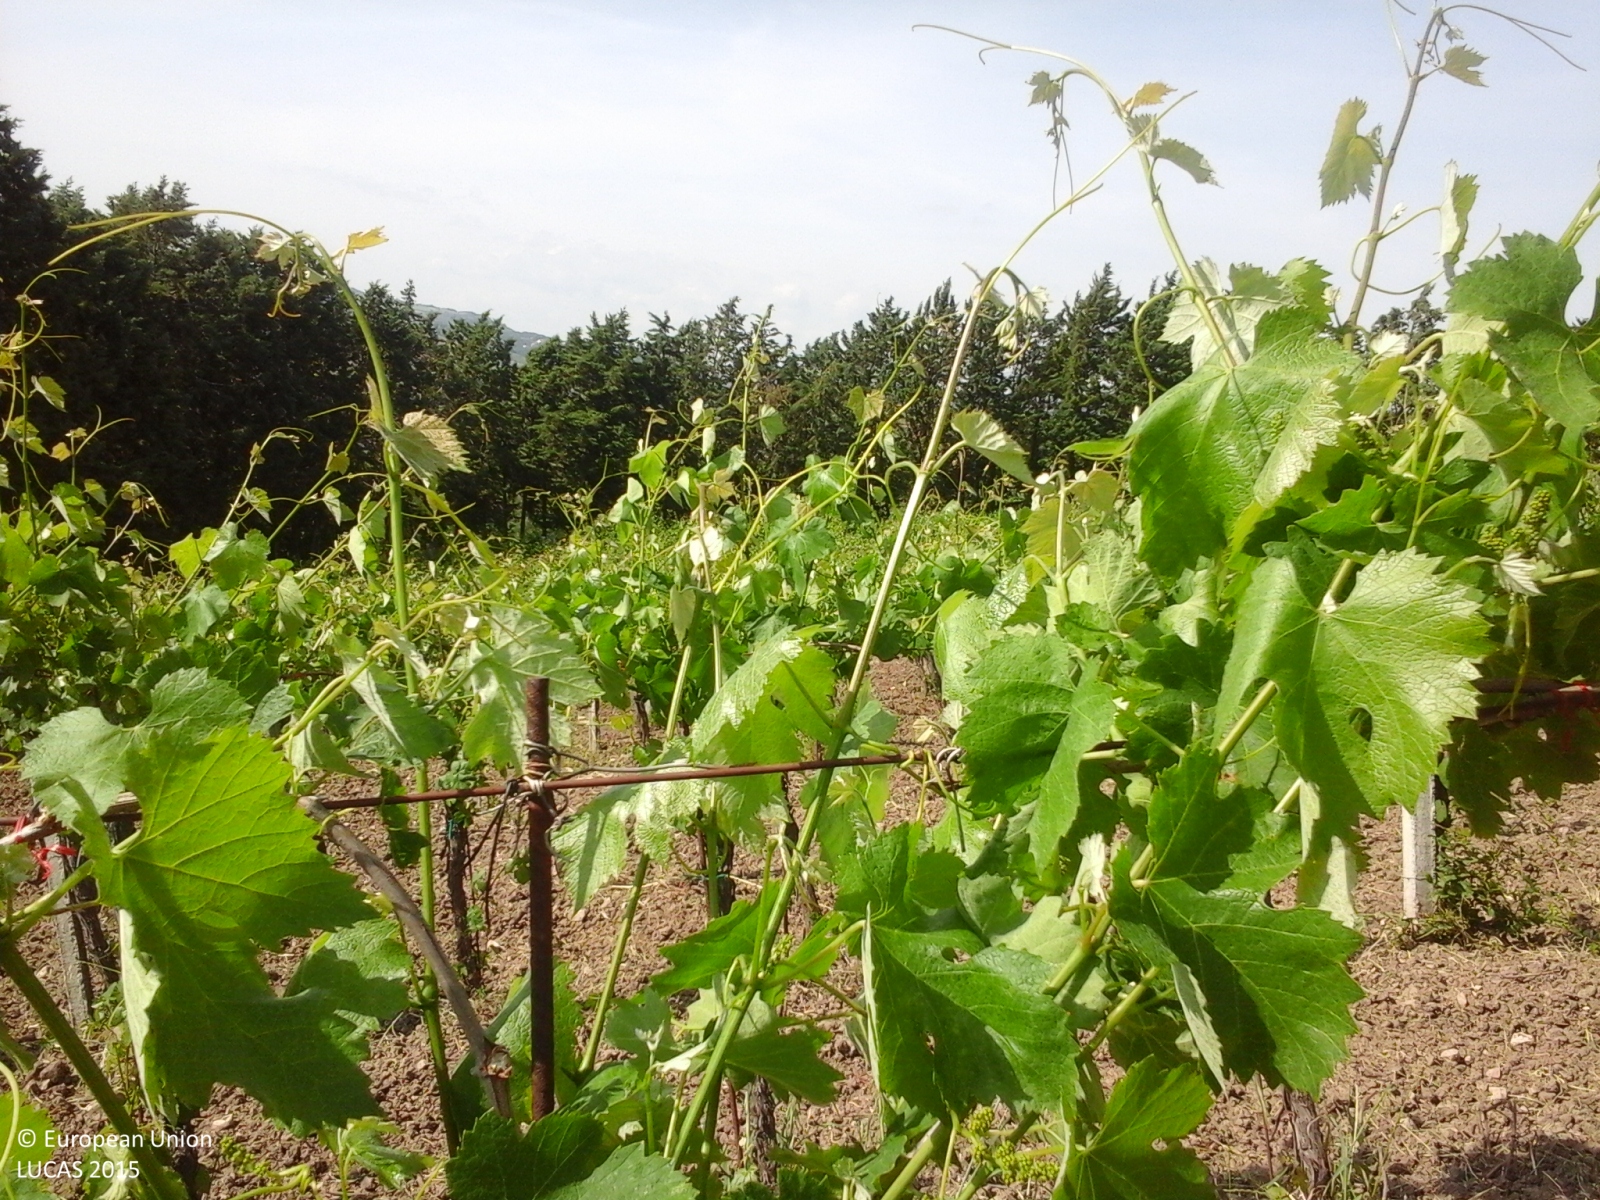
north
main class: Cropland
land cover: Vineyards
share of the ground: 50 - 75 %
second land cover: Other bare soil
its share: > 75 %
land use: Agriculture (excluding fallow land and kitchen gardens)
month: May
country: IT
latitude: 41.2240
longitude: 14.6944
